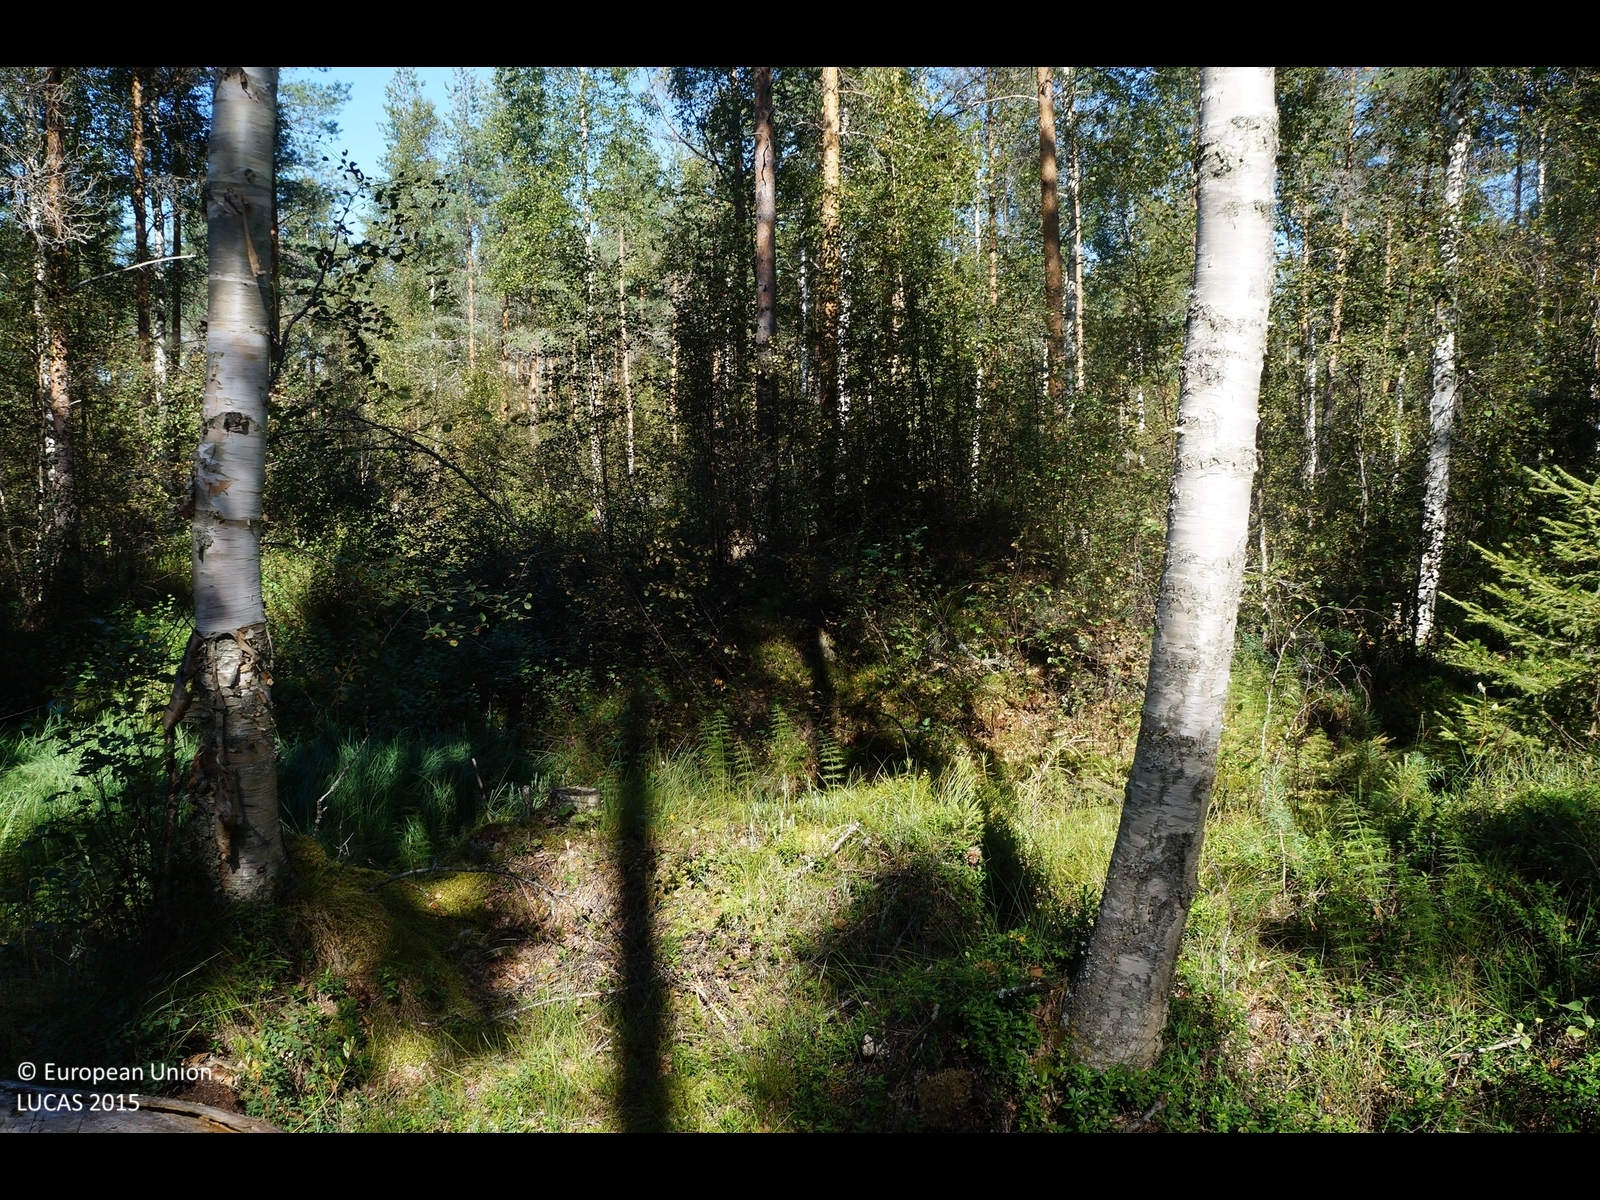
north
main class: Woodland
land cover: Other mixed woodland
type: boreal forest
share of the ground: 50 - 75 %
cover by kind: coniferous forest trees 35 %, shrubs 30 %, broadleaved forest trees 20 %, lichens and mosses 10 %, herbaceous plants 5 %
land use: Forestry
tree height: > 5 m
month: August
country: FI
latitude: 63.9393
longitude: 23.7928
